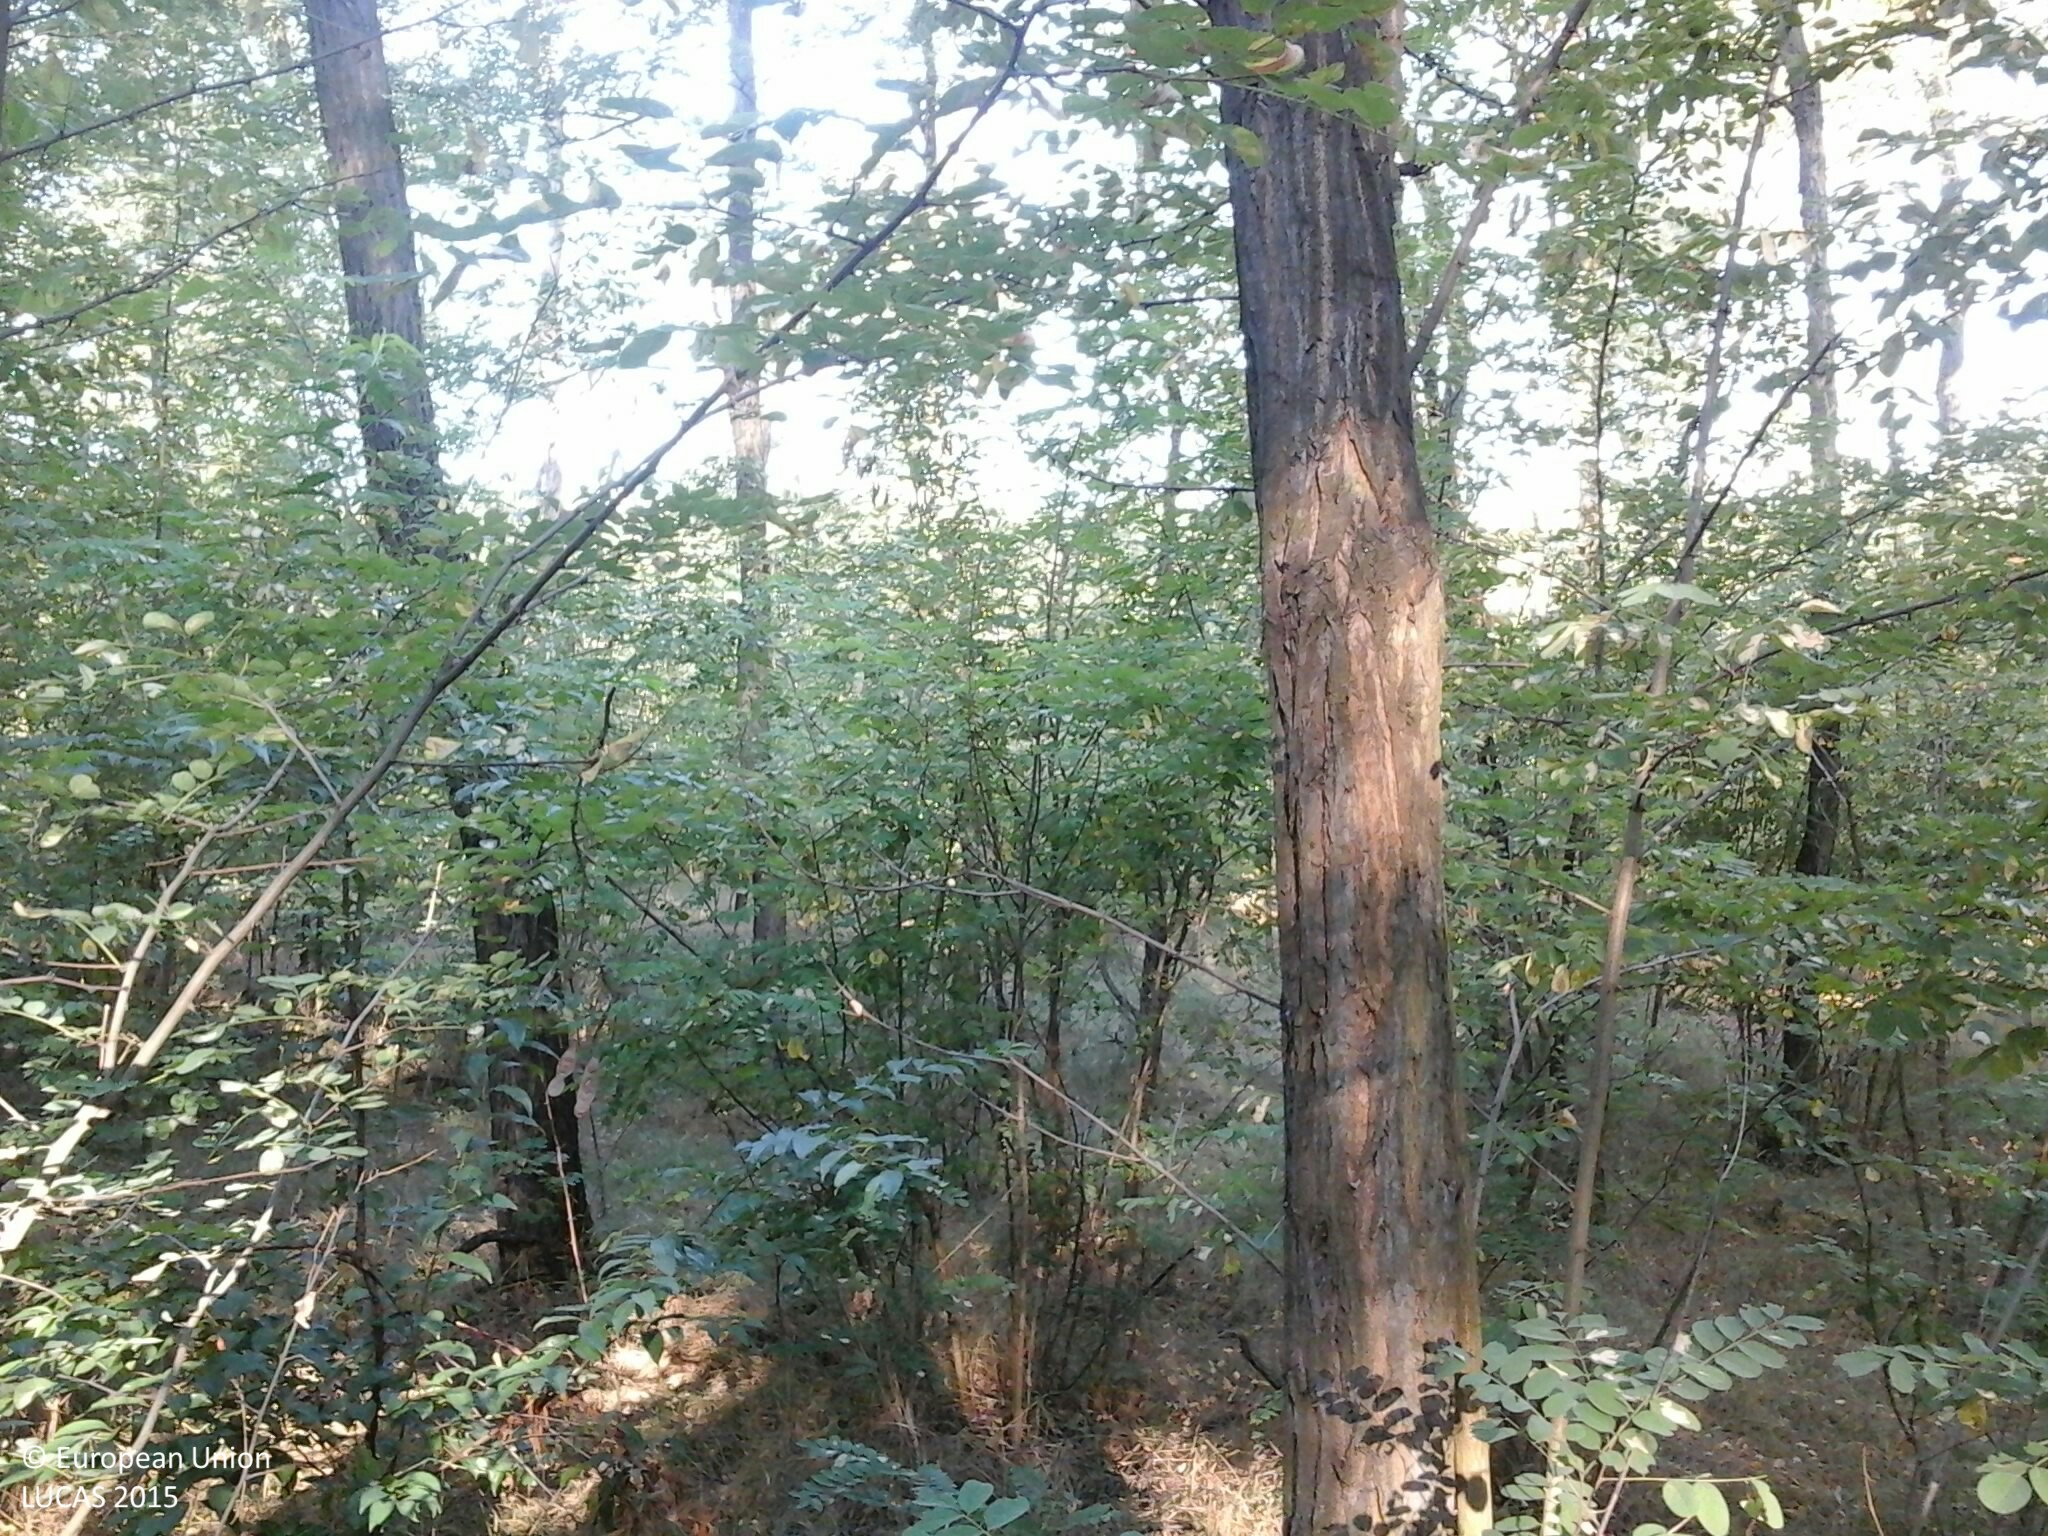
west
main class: Woodland
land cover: Broadleaved woodland
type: exotic forest
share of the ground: > 75 %
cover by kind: broadleaved forest trees 80 %, herbaceous plants 15 %, shrubs 5 %
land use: Forestry
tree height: > 5 m
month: July
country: HU
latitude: 47.6630
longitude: 22.1032
